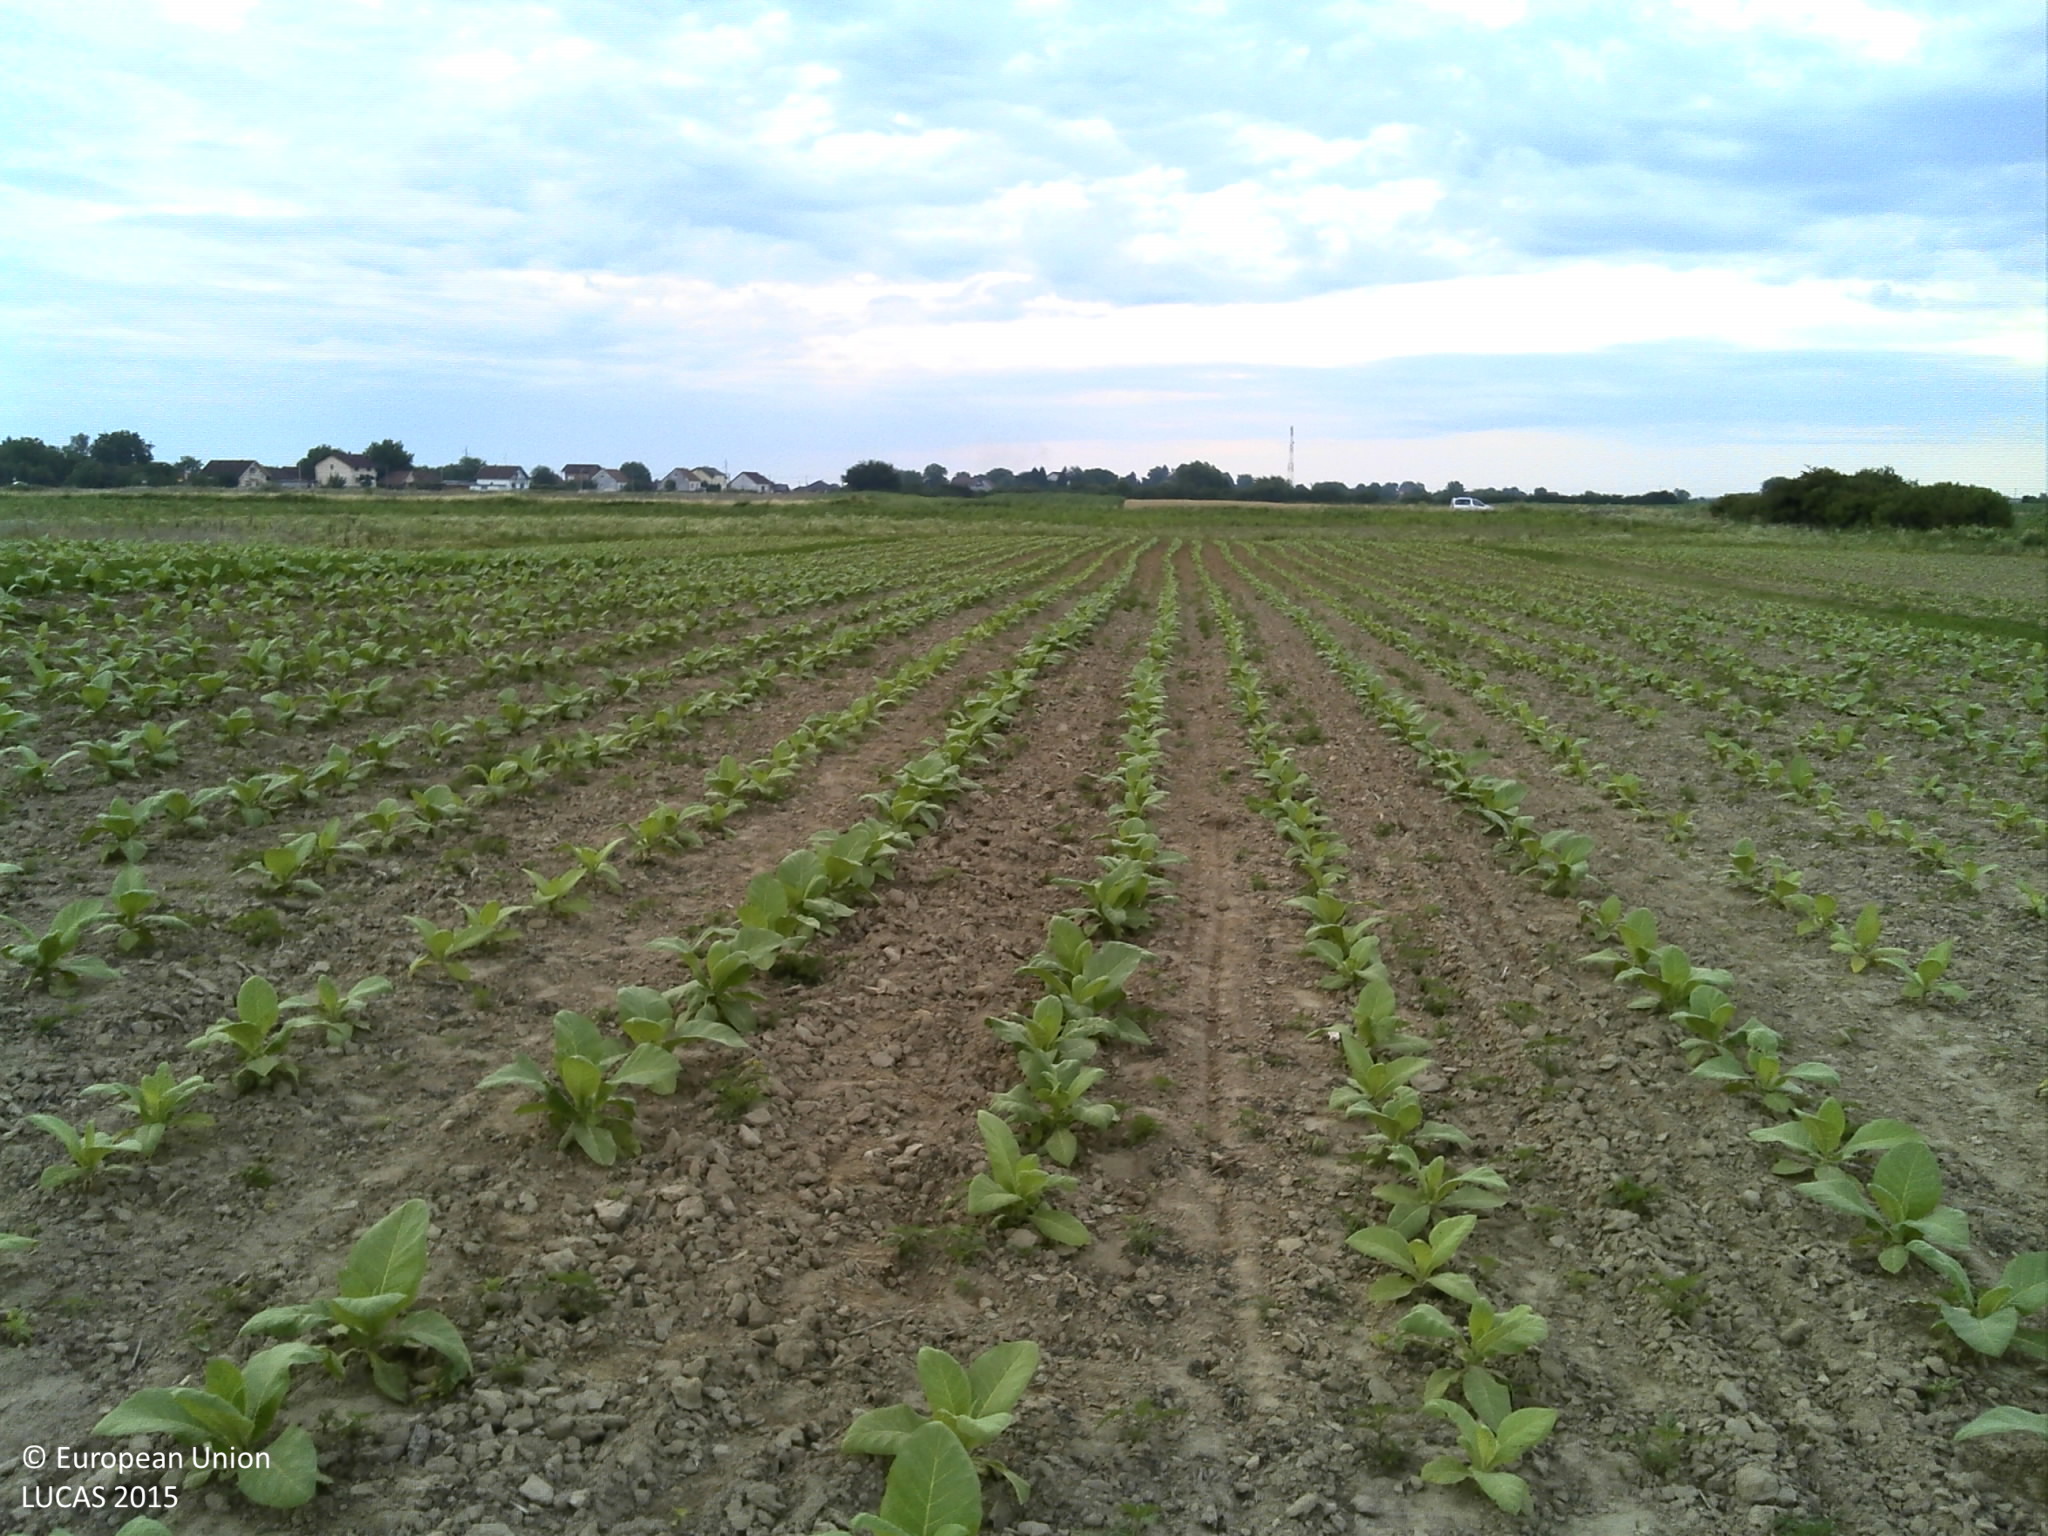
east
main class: Cropland
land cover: Sugar beet
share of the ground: < 10 %
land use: Agriculture (excluding fallow land and kitchen gardens)
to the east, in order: Sugar beet; Other bare soil; Maize; Ditches and canals; Grass margins; Tracks; Maize
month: June
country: HR
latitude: 45.7765
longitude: 17.5520
